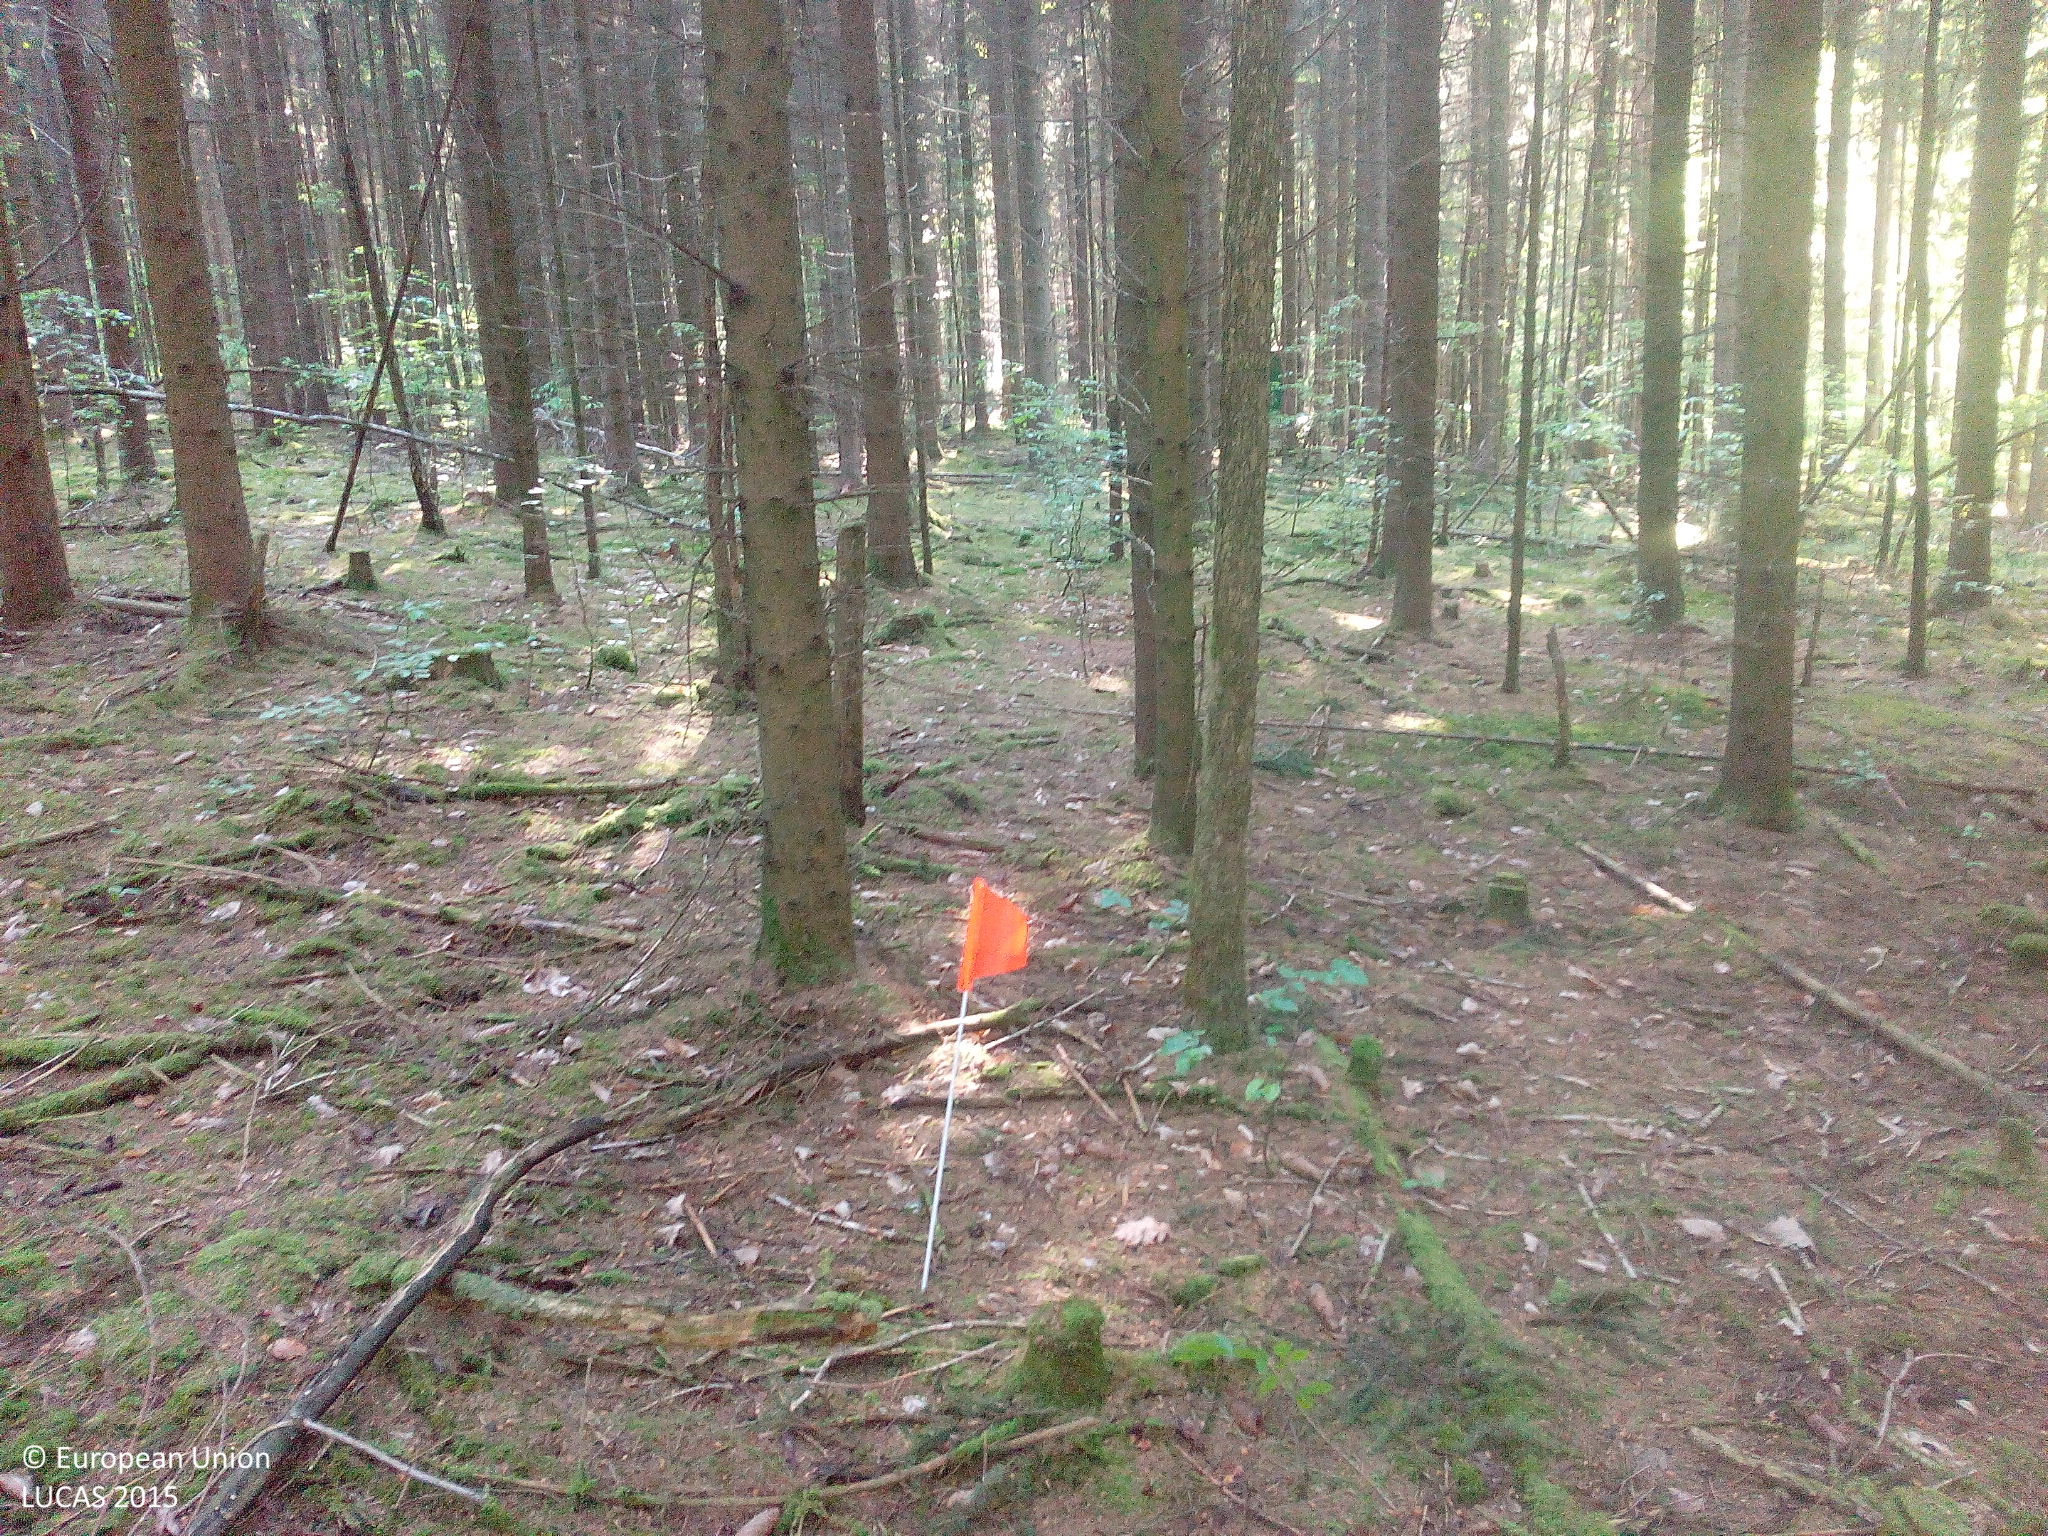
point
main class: Woodland
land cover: Spruce dominated coniferous woodland
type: hemiboreal forest and nemoral coniferous forest and mixed broadleaved-coniferous forest
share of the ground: > 75 %
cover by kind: coniferous forest trees 100 %
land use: Forestry
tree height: > 5 m
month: May
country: DE
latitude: 49.9826
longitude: 10.9341
